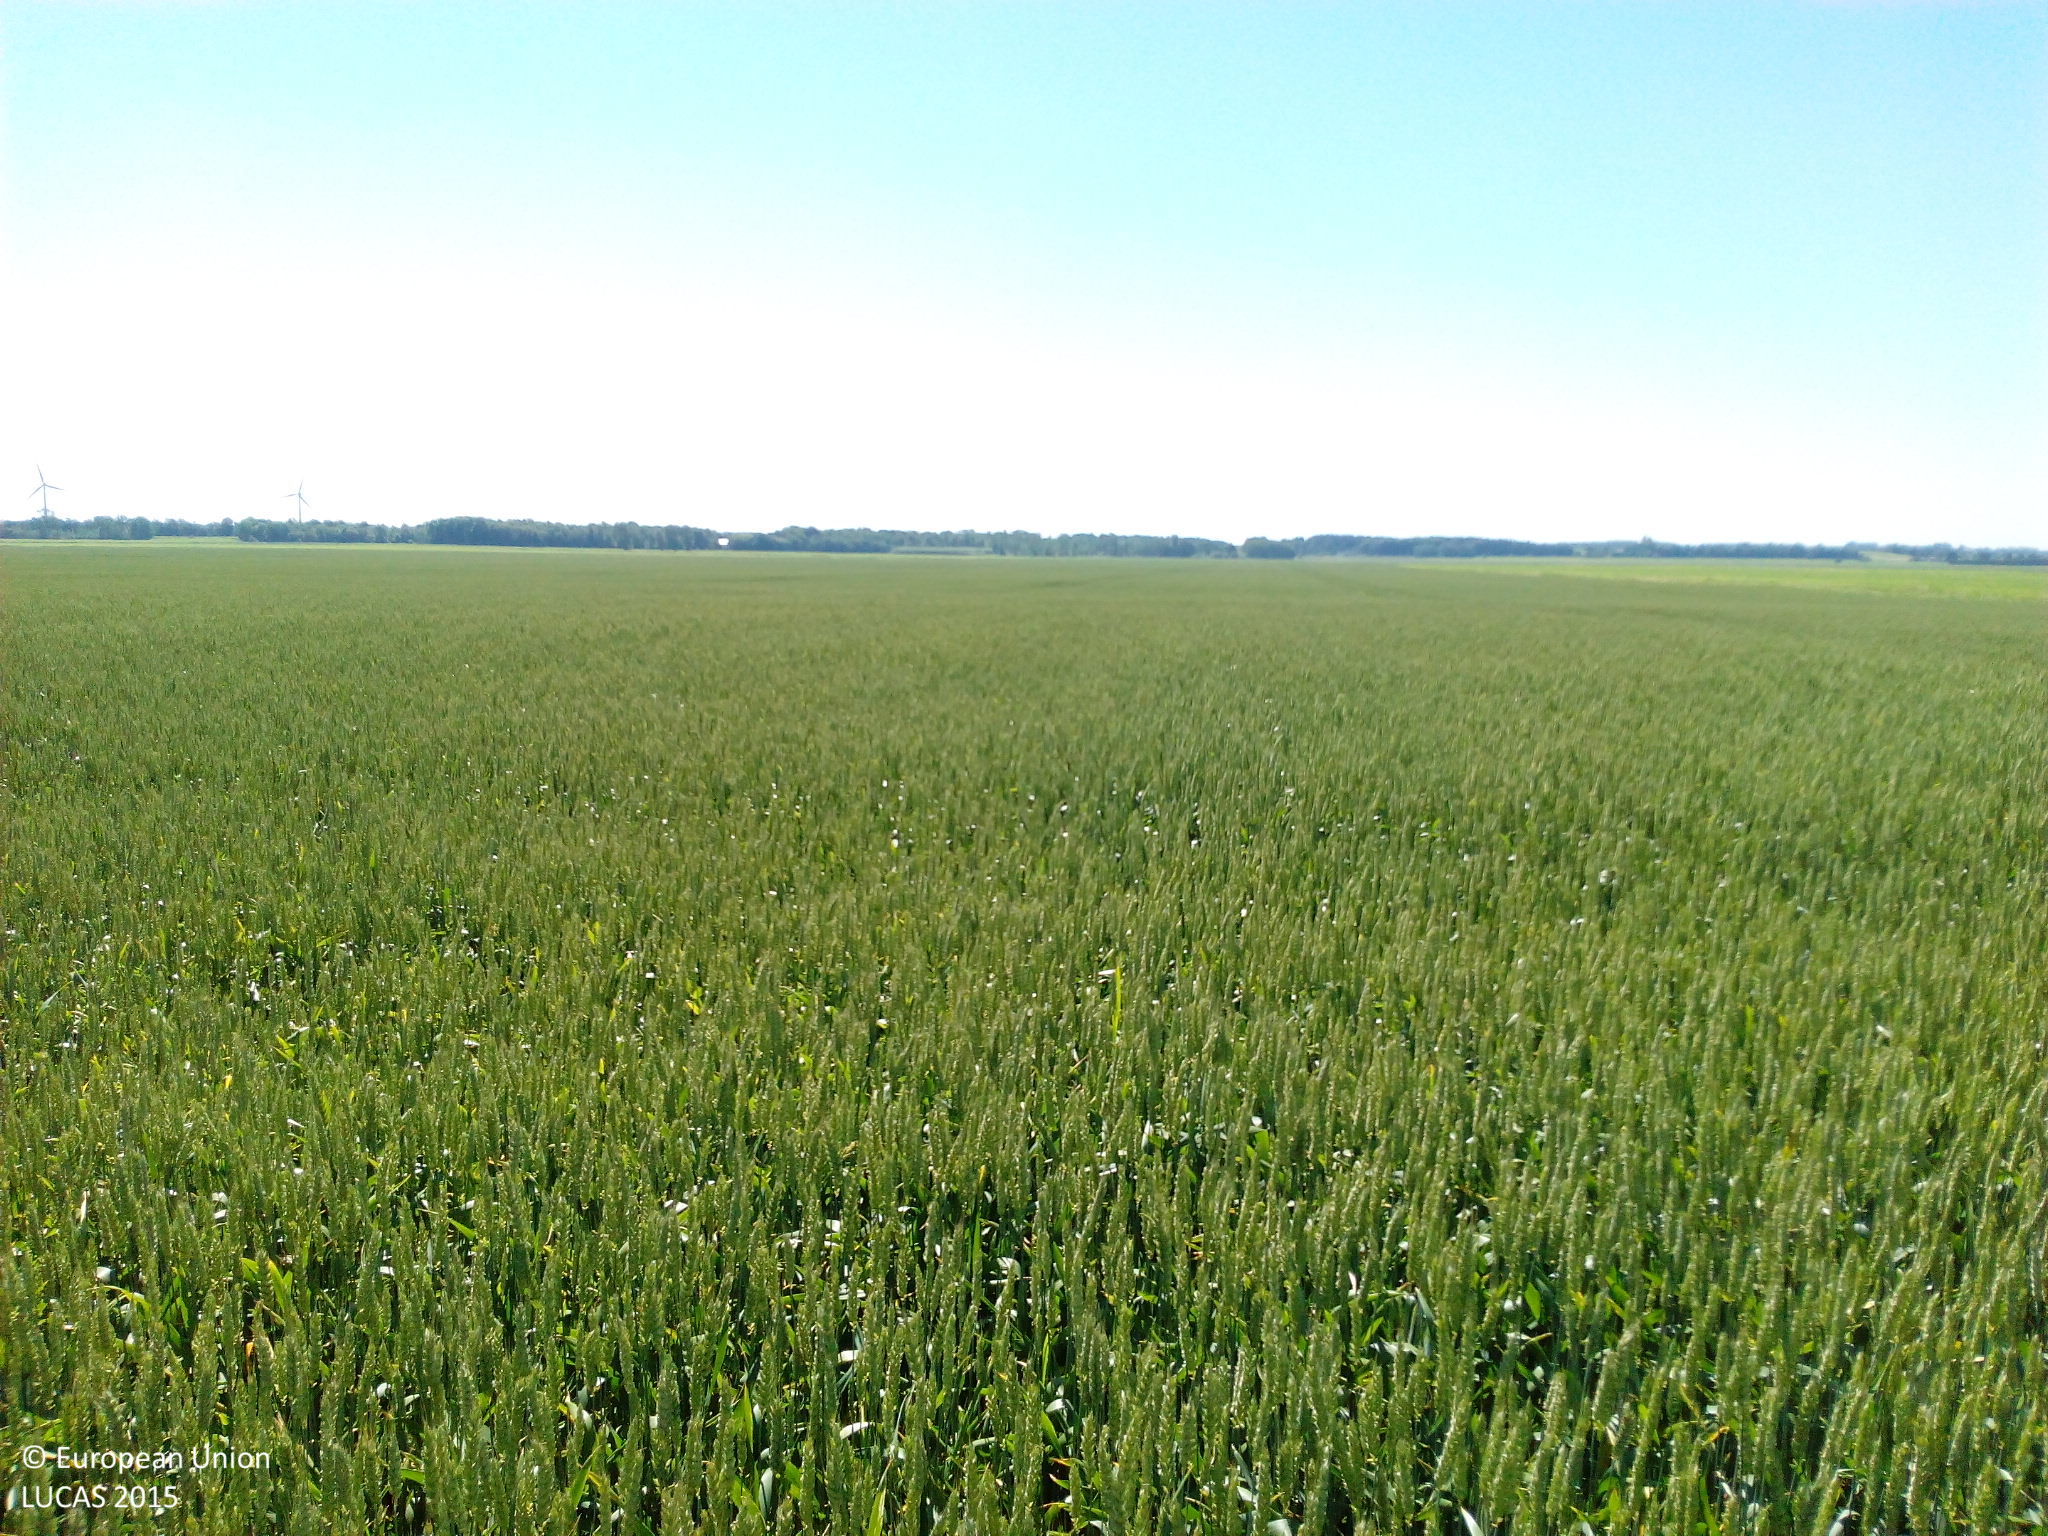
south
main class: Cropland
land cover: Common wheat
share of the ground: > 75 %
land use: Agriculture (excluding fallow land and kitchen gardens)
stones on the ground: 10 - 25 %
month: July
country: DK
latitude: 56.3838
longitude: 10.6632
